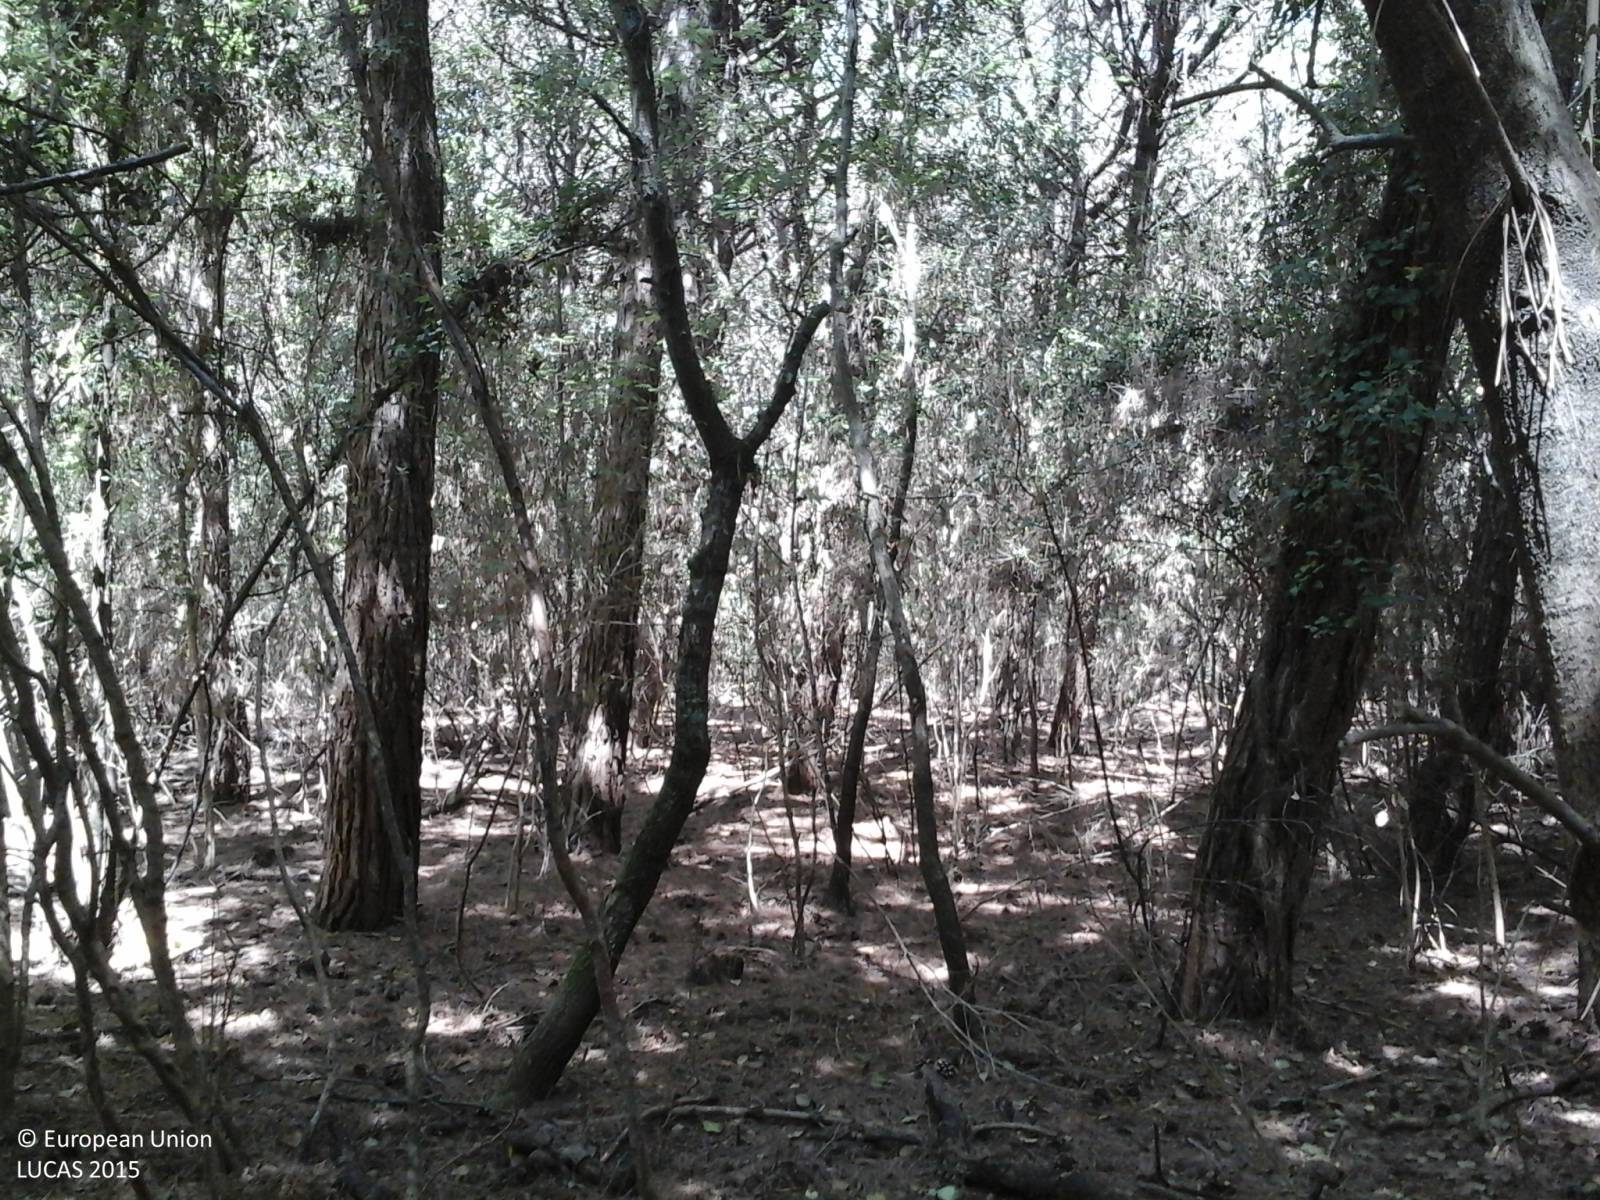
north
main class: Woodland
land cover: Pine dominated mixed woodland
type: coniferous forest of the mediterranean region
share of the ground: > 75 %
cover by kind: coniferous forest trees 75 %, broadleaved forest trees 25 %
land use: Semi-natural and natural areas not in use
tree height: > 5 m
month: August
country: IT
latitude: 41.3059
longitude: 13.0571
